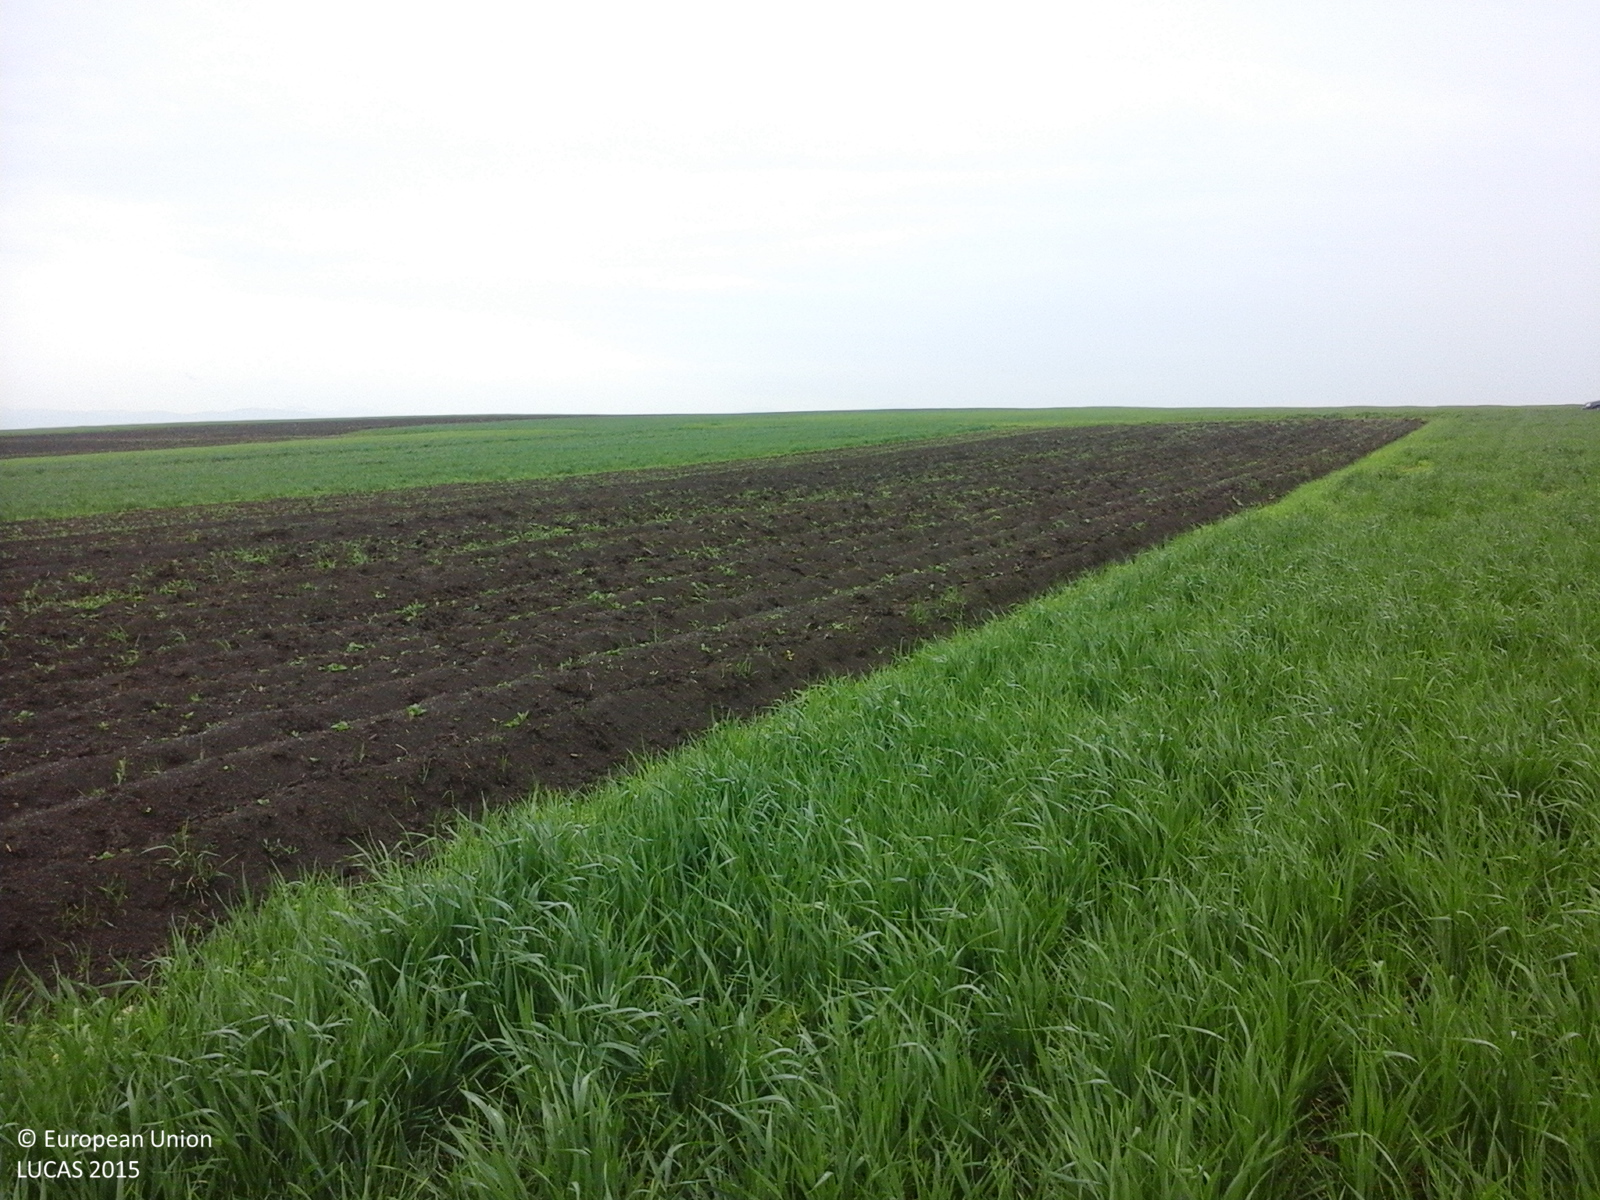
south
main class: Cropland
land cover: Common wheat
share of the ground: > 75 %
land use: Agriculture (excluding fallow land and kitchen gardens)
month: May
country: RO
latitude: 45.9409
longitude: 26.0212
